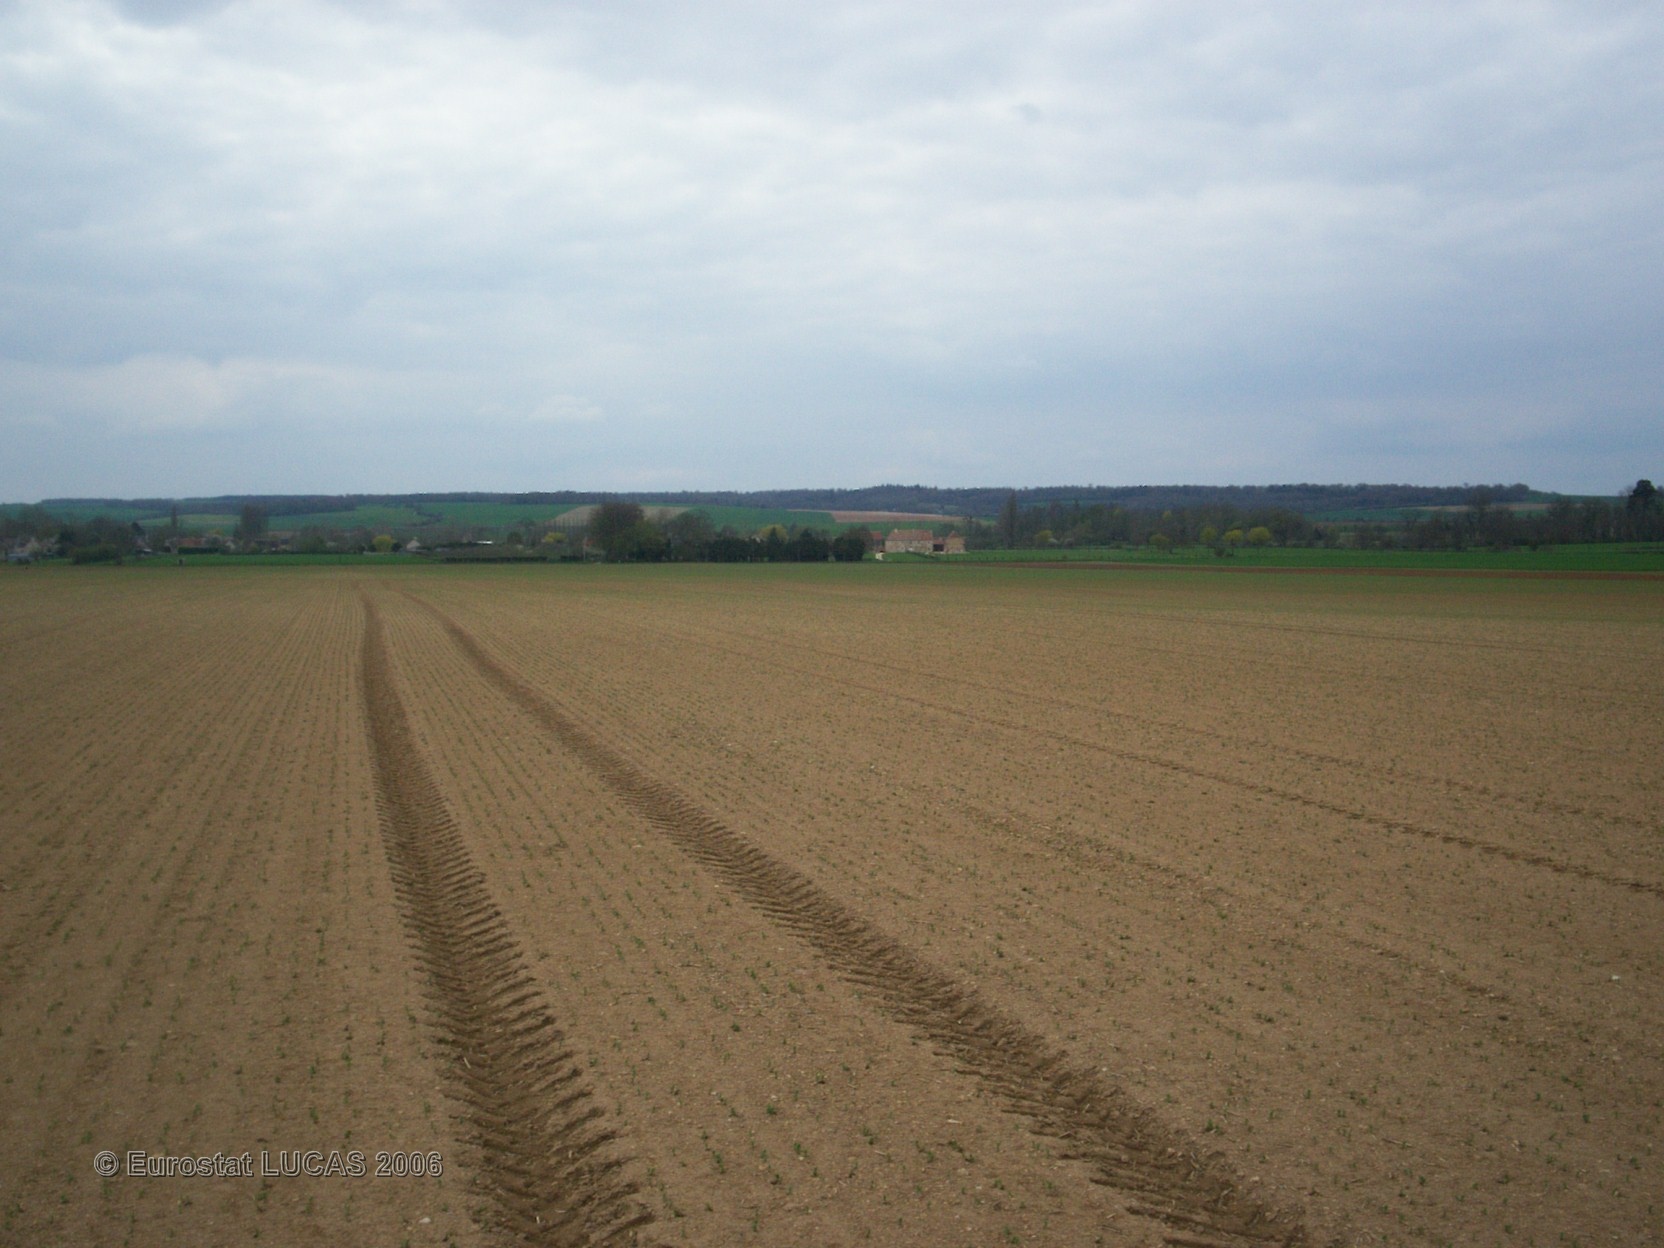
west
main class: Cropland
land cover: Dry pulses
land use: Agriculture (excluding fallow land and kitchen gardens)
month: April
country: FR
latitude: 48.9401
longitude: -0.0658
